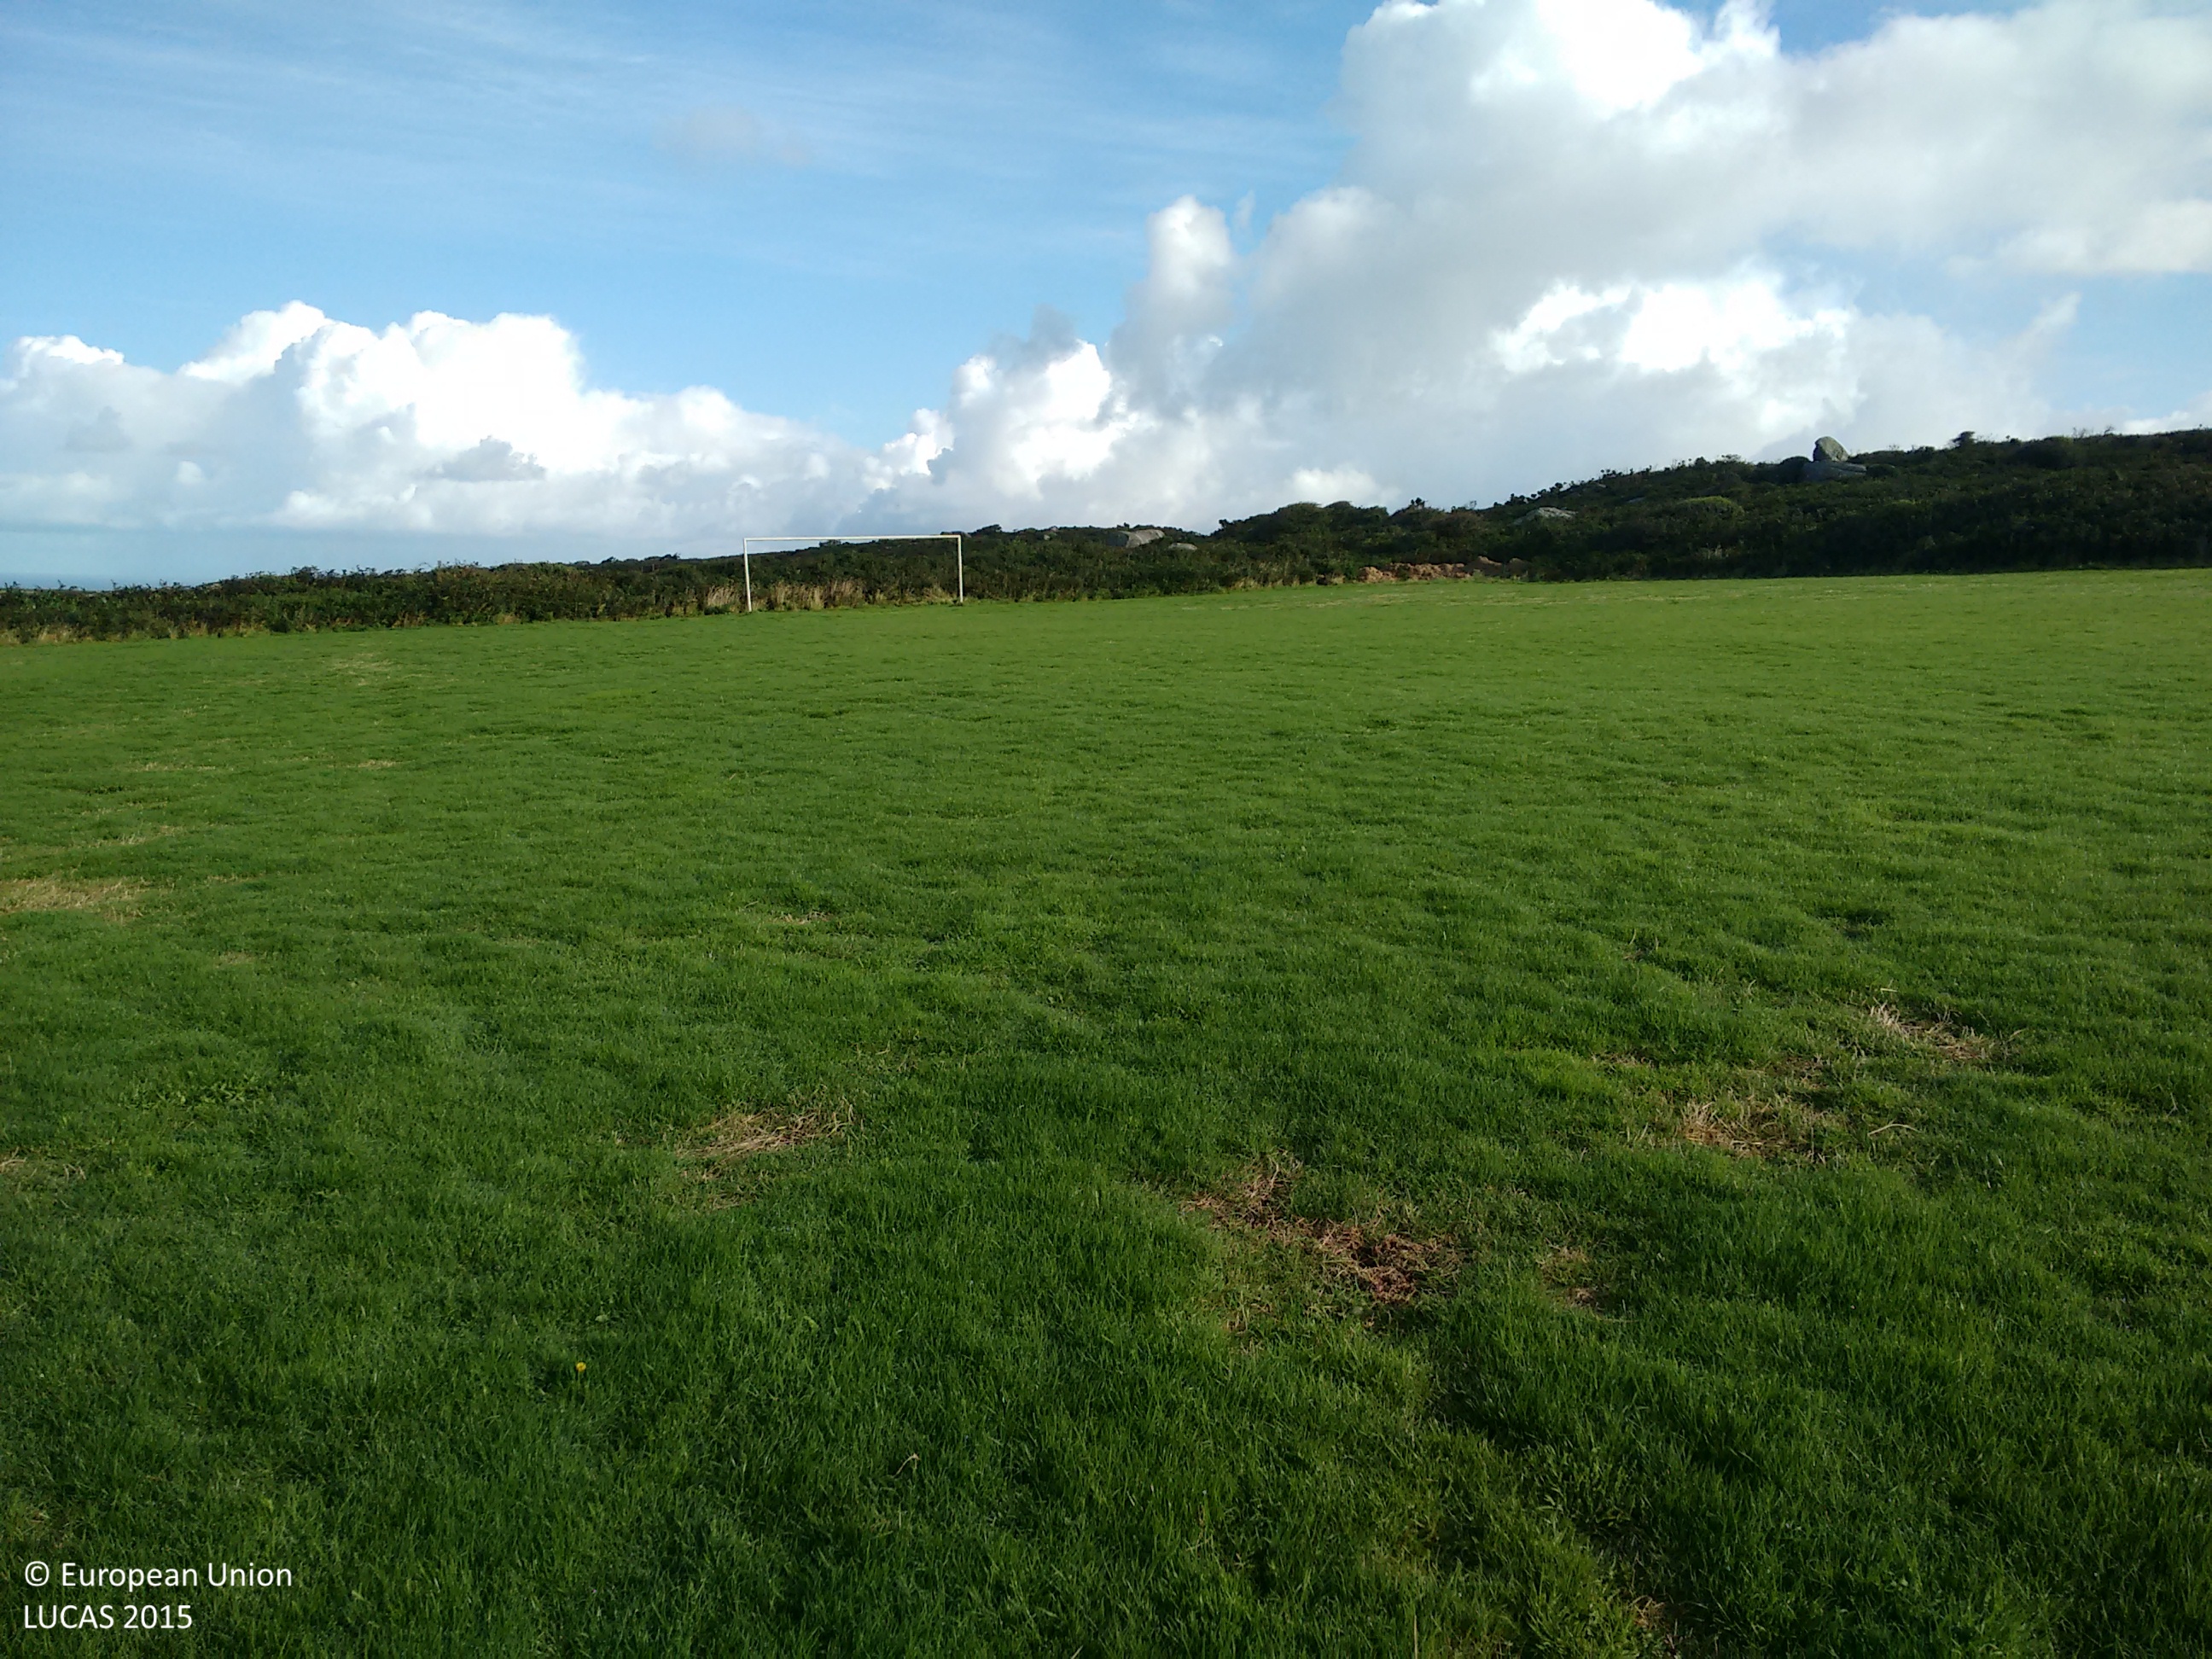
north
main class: Grassland
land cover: Grassland without tree/shrub cover
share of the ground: > 75 %
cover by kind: herbaceous plants 100 %
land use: Sport
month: August
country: GB
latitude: 50.1970
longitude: -5.4950
